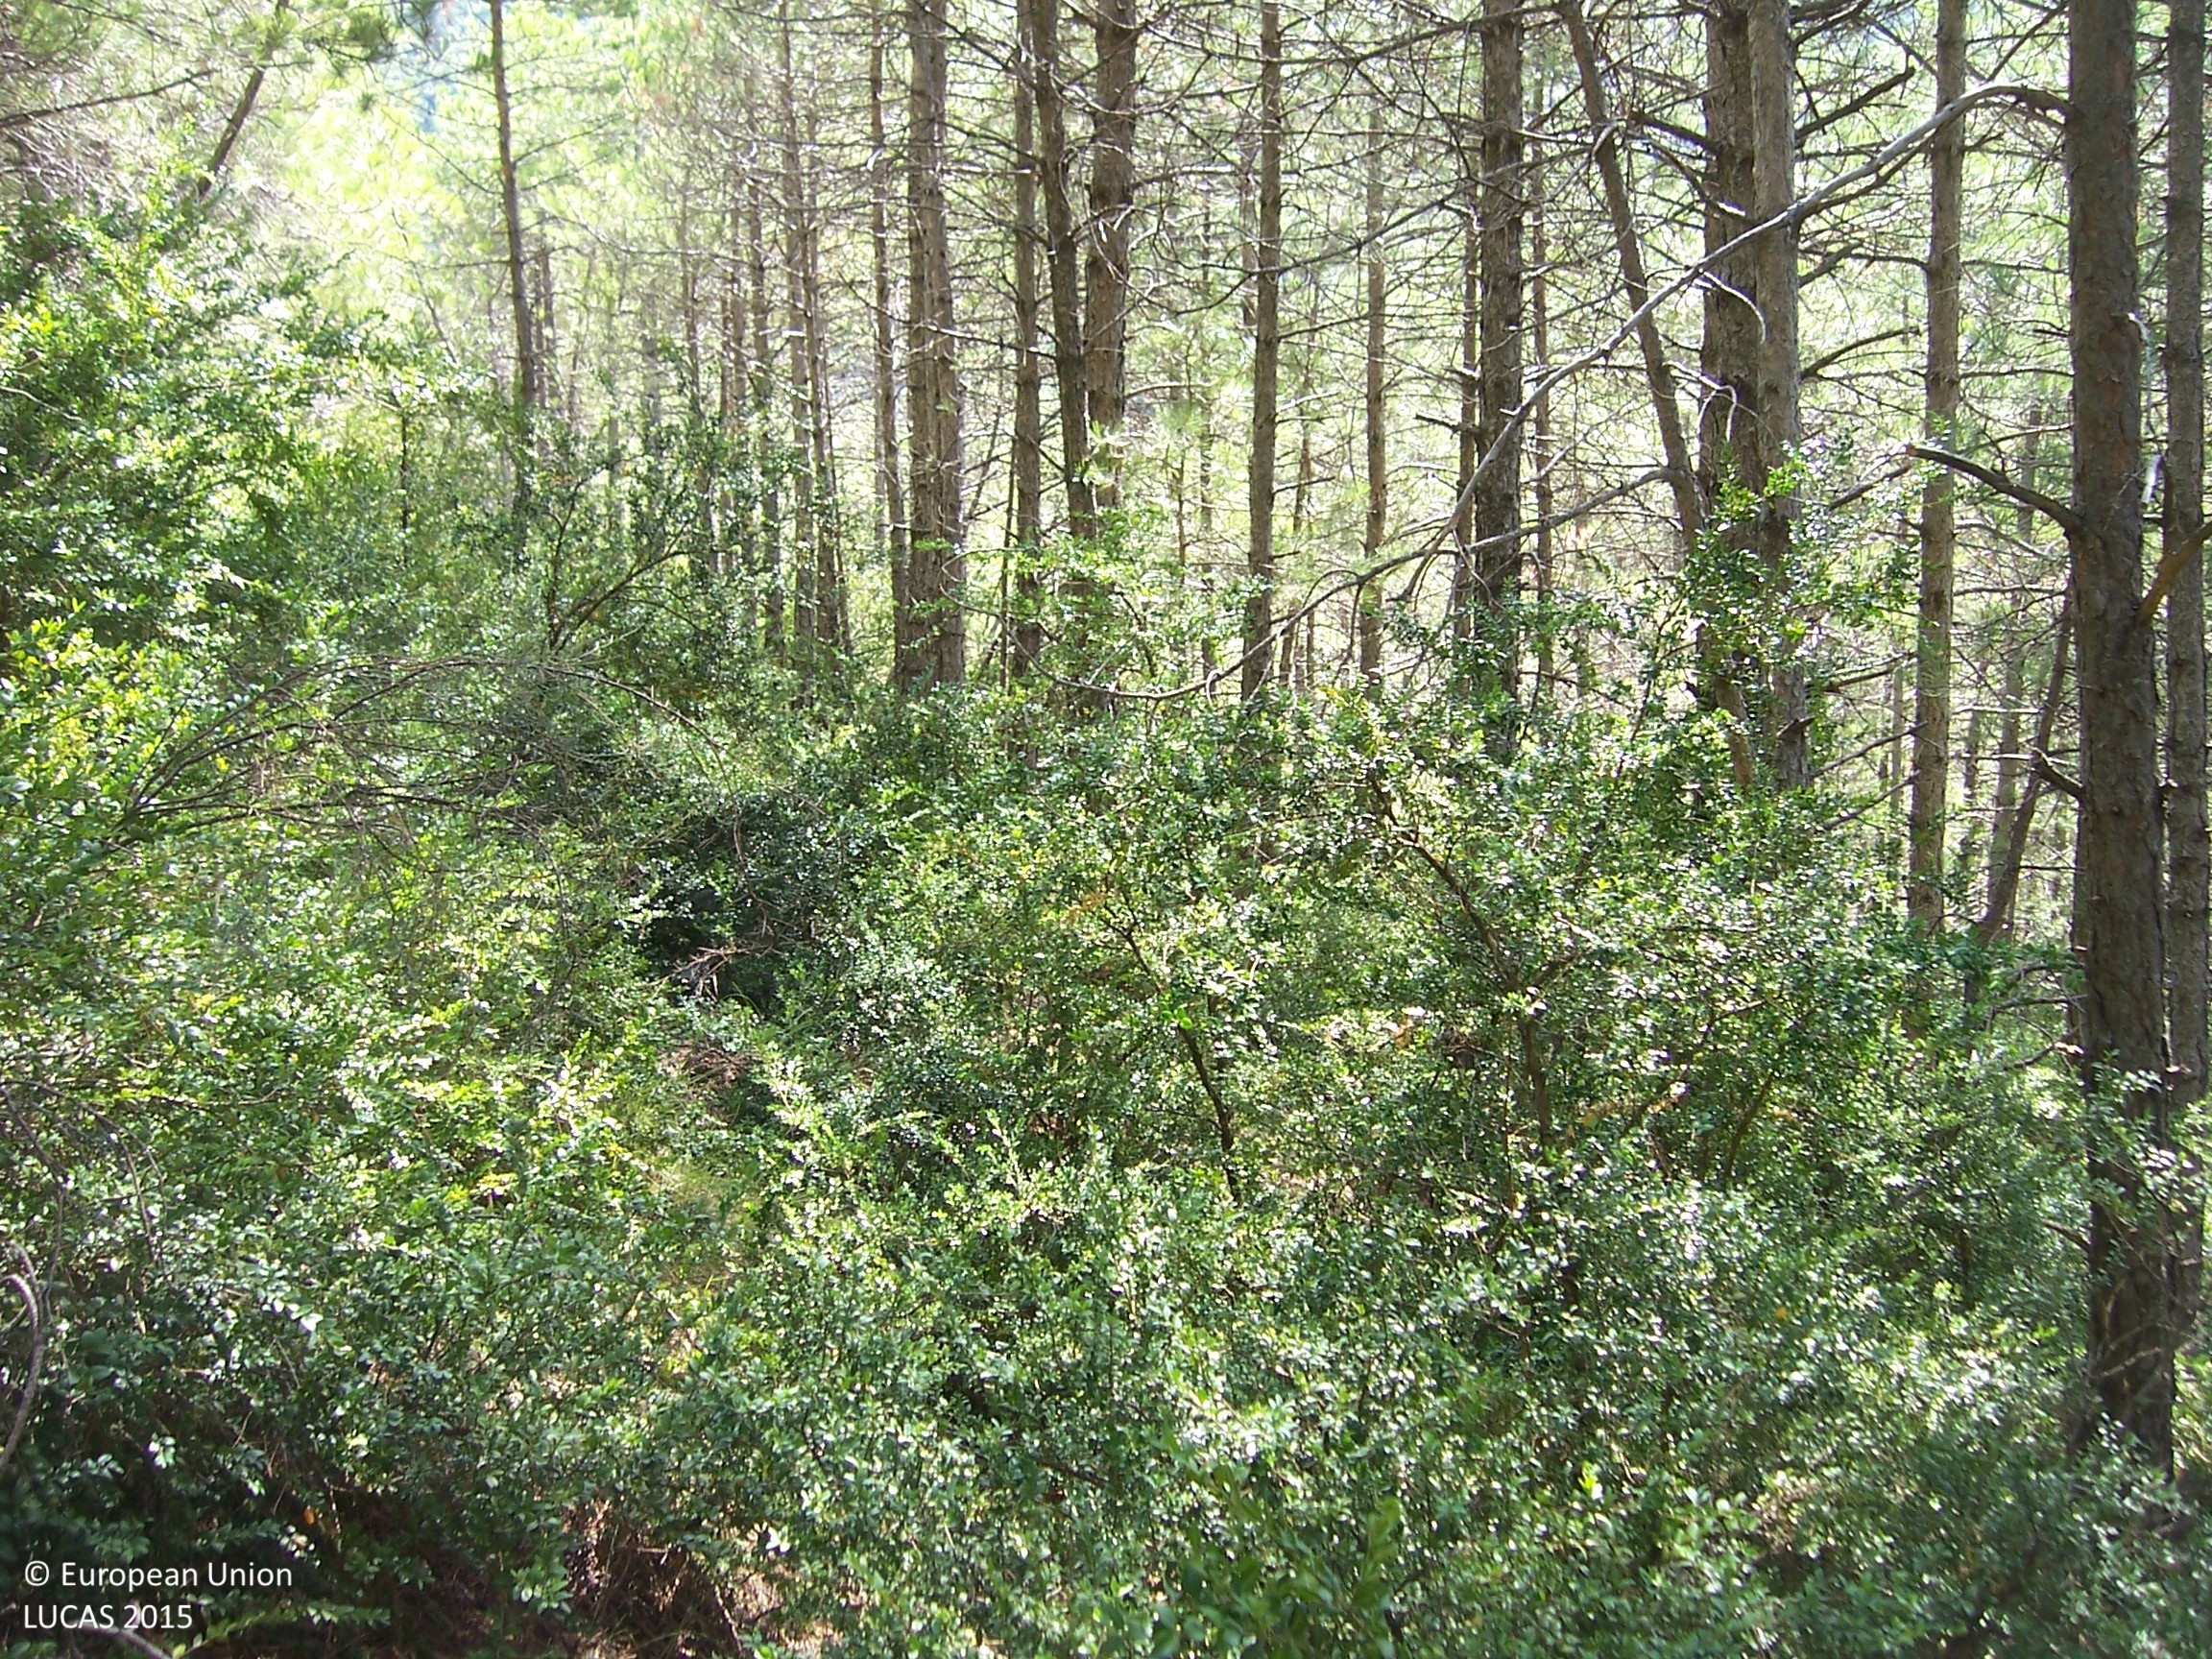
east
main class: Woodland
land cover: Pine dominated coniferous woodland
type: coniferous forest of the mediterranean region
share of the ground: > 75 %
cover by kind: coniferous forest trees 100 %
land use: Forestry
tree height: > 5 m
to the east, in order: Pine dominated coniferous woodland; Rivers and streams; Shrubland with sparse tree cover
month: August
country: ES
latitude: 42.5856
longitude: -0.4448
